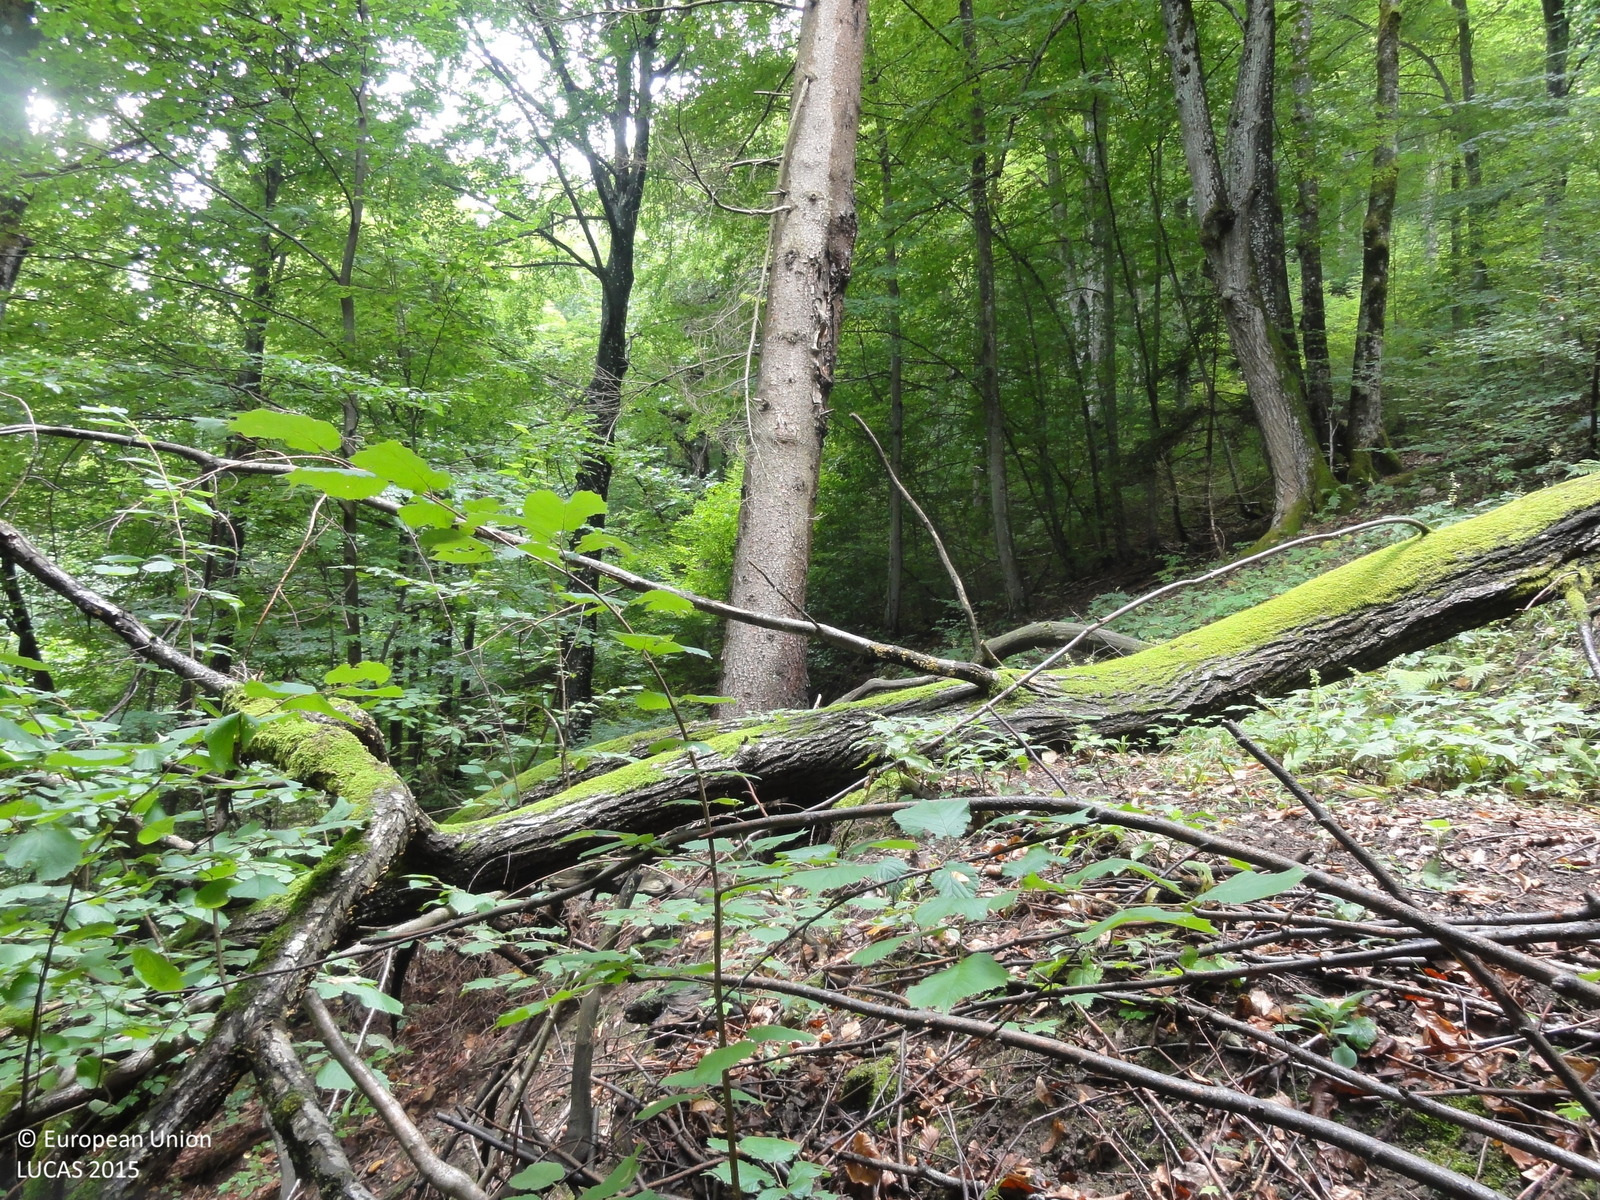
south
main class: Woodland
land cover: Broadleaved woodland
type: beech forest
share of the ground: > 75 %
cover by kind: broadleaved forest trees 90 %, coniferous forest trees 10 %
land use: Forestry
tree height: > 5 m
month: August
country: SI
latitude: 45.6704
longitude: 15.0922
